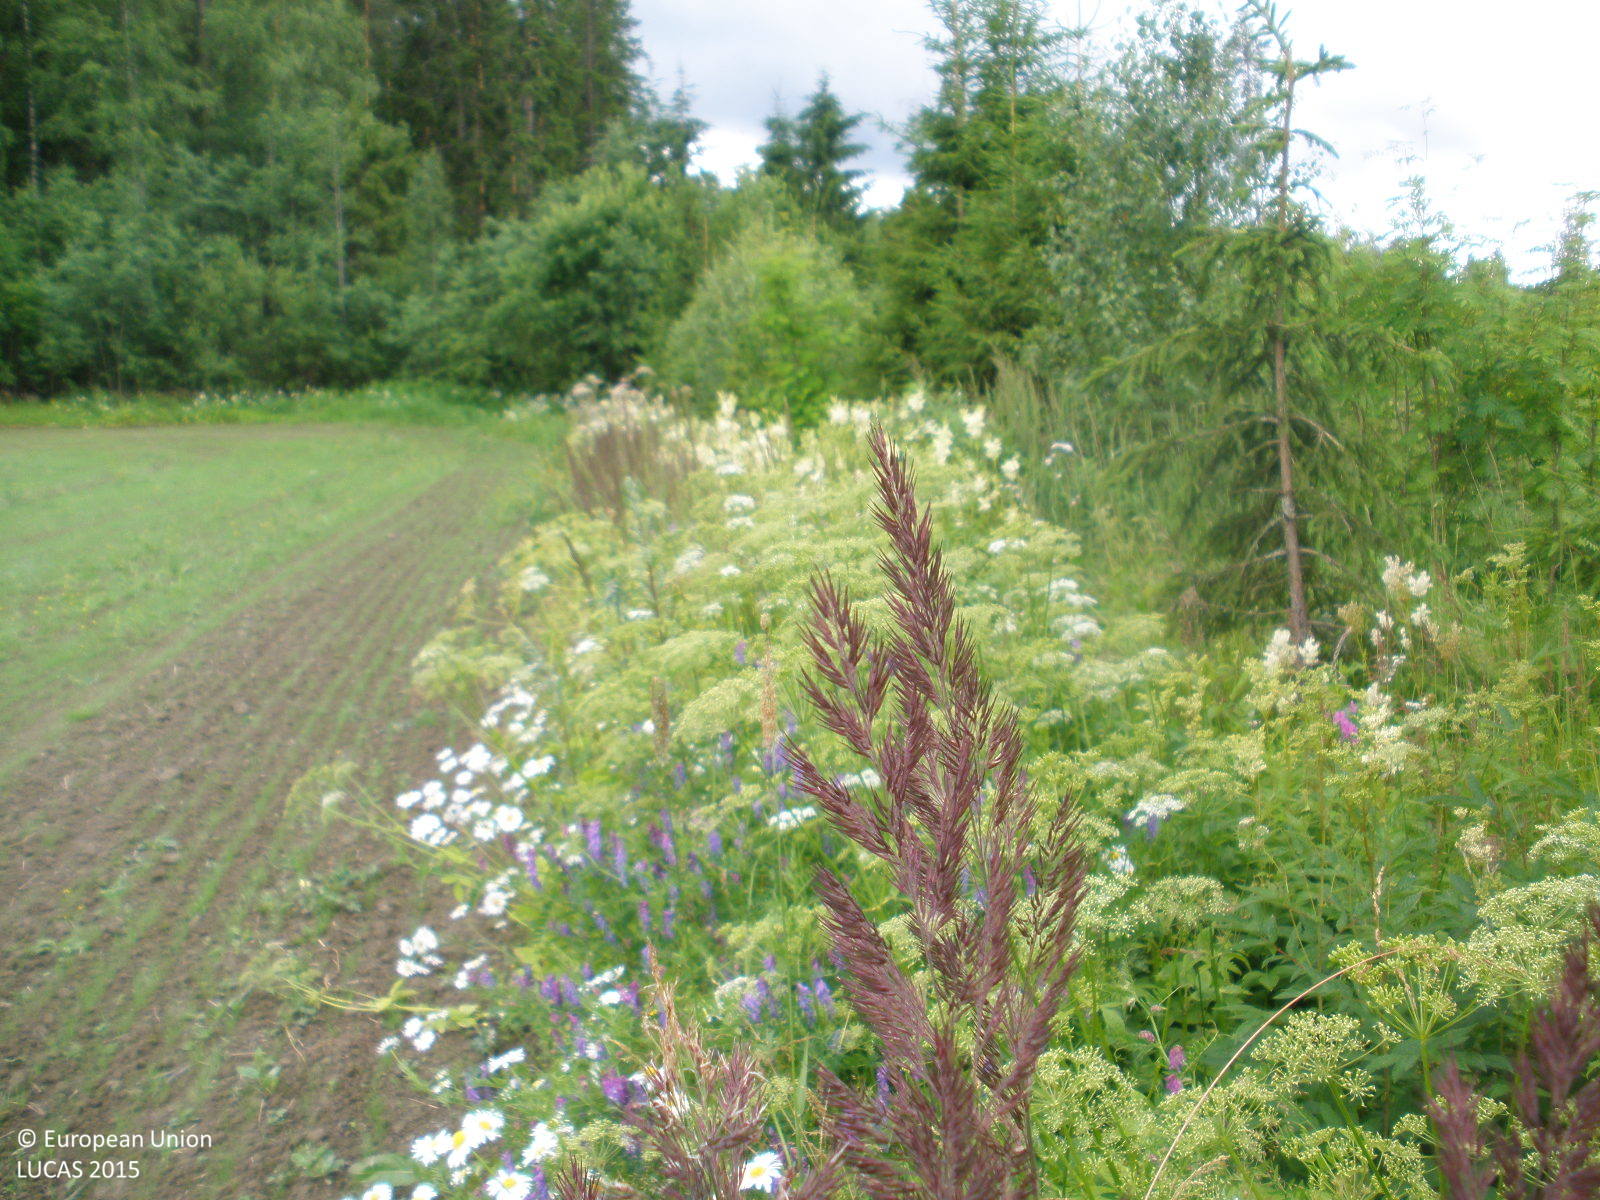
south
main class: Cropland
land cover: Oats
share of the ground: < 10 %
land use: Agriculture (excluding fallow land and kitchen gardens)
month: July
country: FI
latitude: 61.4888
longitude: 24.6181
